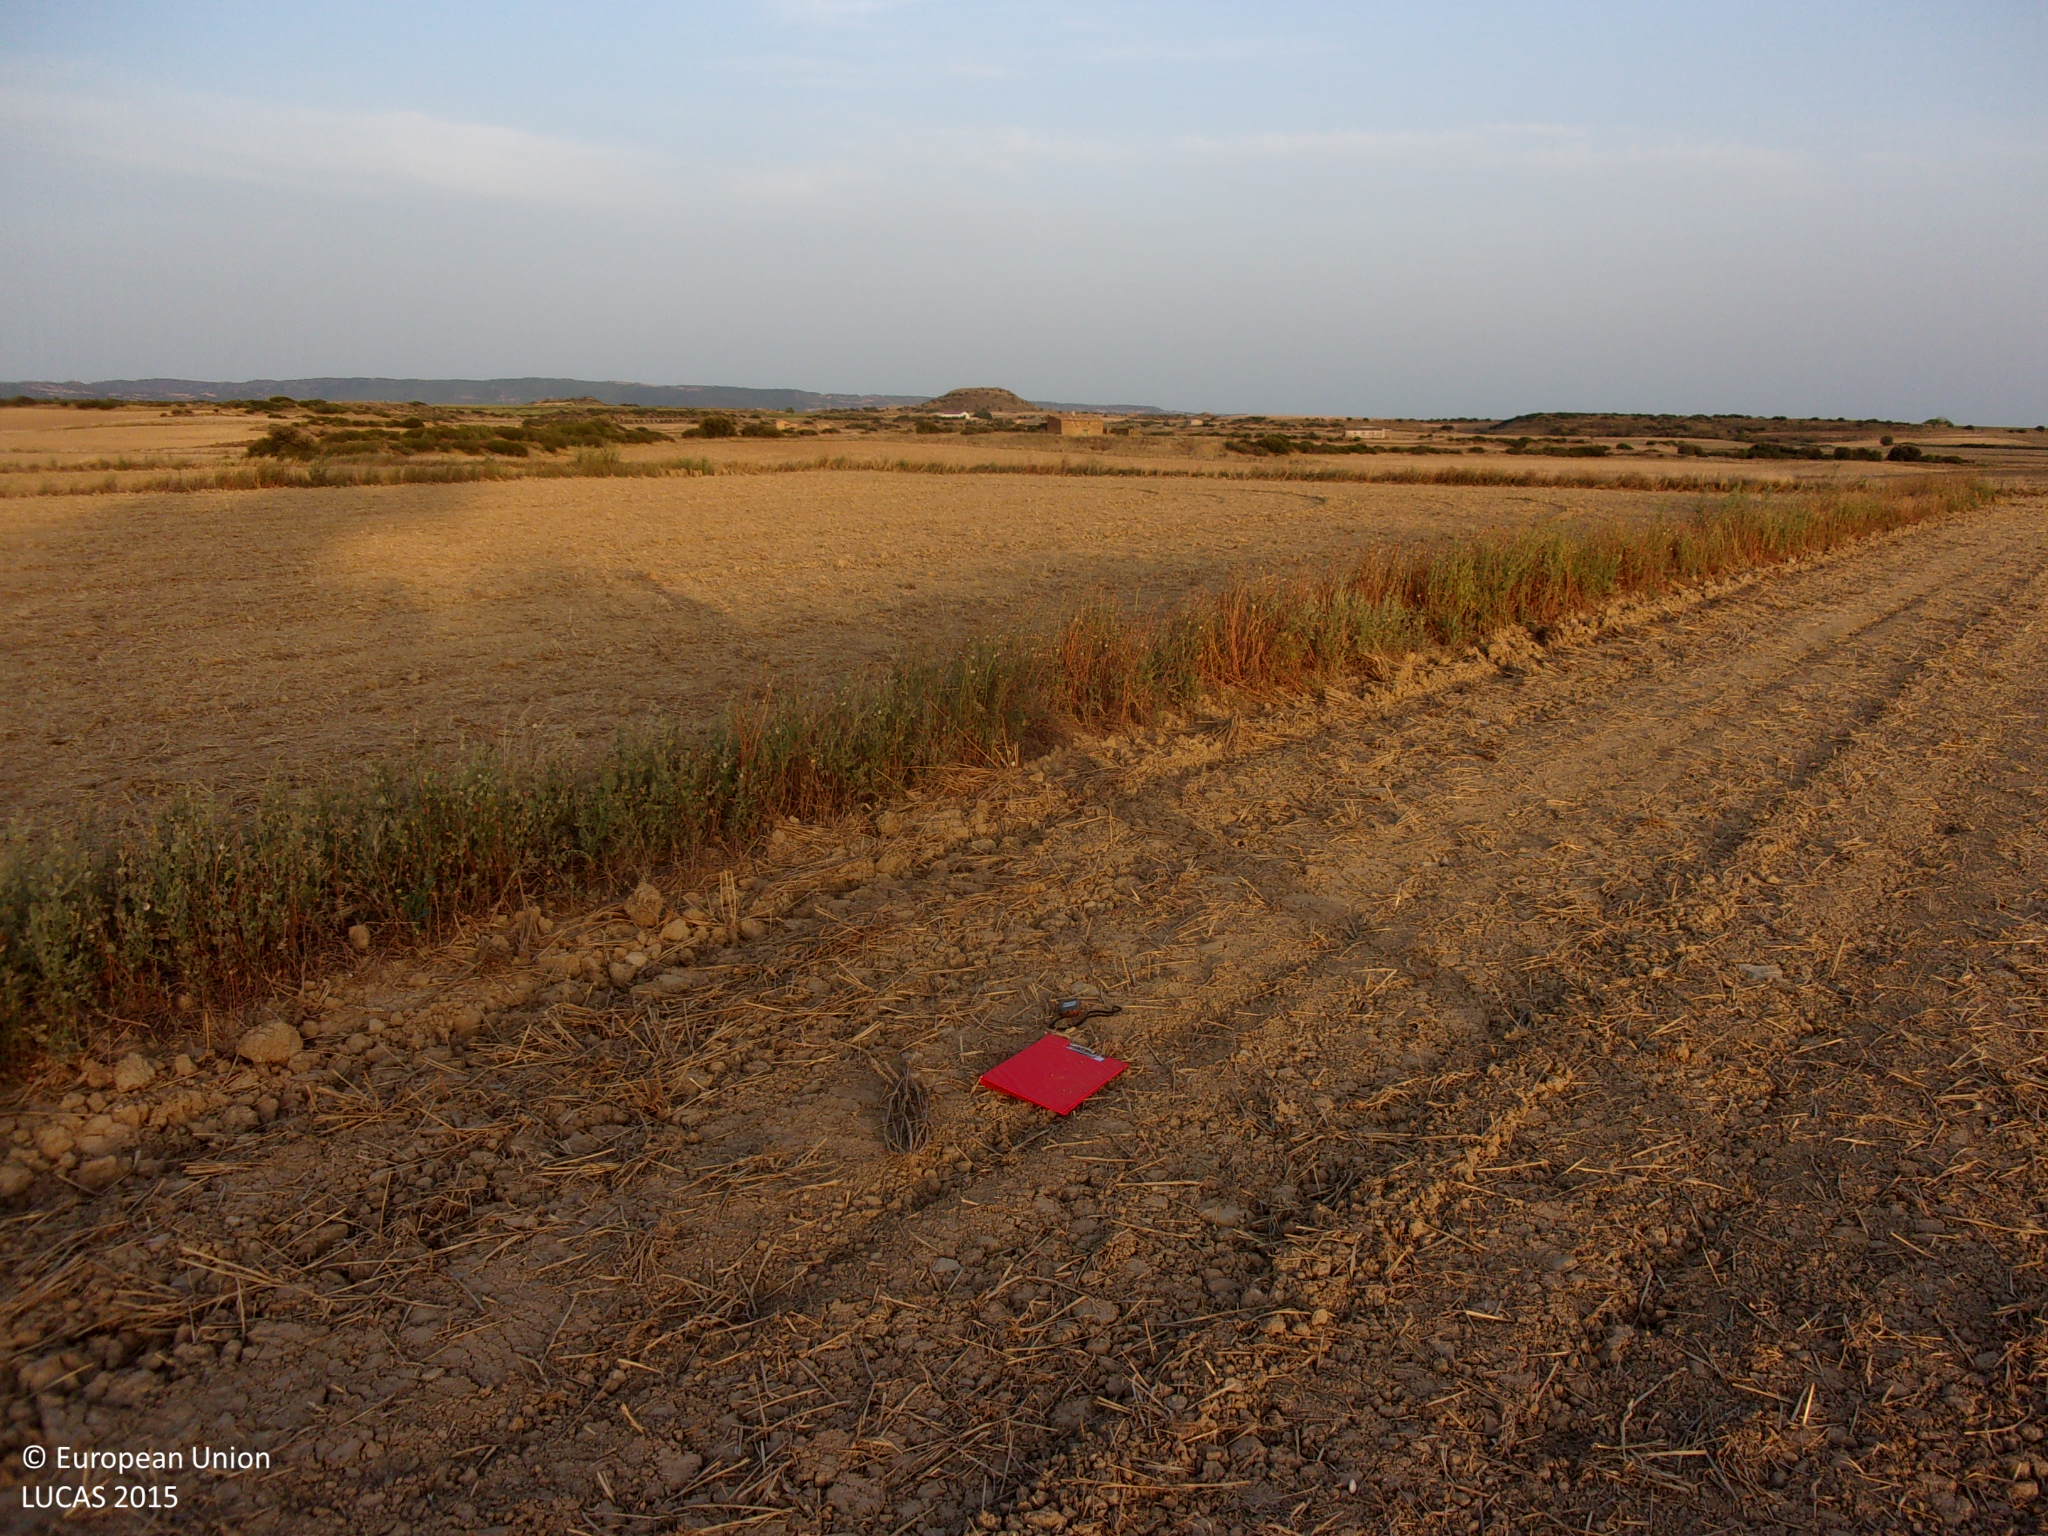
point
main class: Cropland
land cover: Common wheat
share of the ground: < 10 %
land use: Agriculture (excluding fallow land and kitchen gardens)
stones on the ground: < 10 %
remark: Harvested field
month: August
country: ES
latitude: 42.4275
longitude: -1.3977
